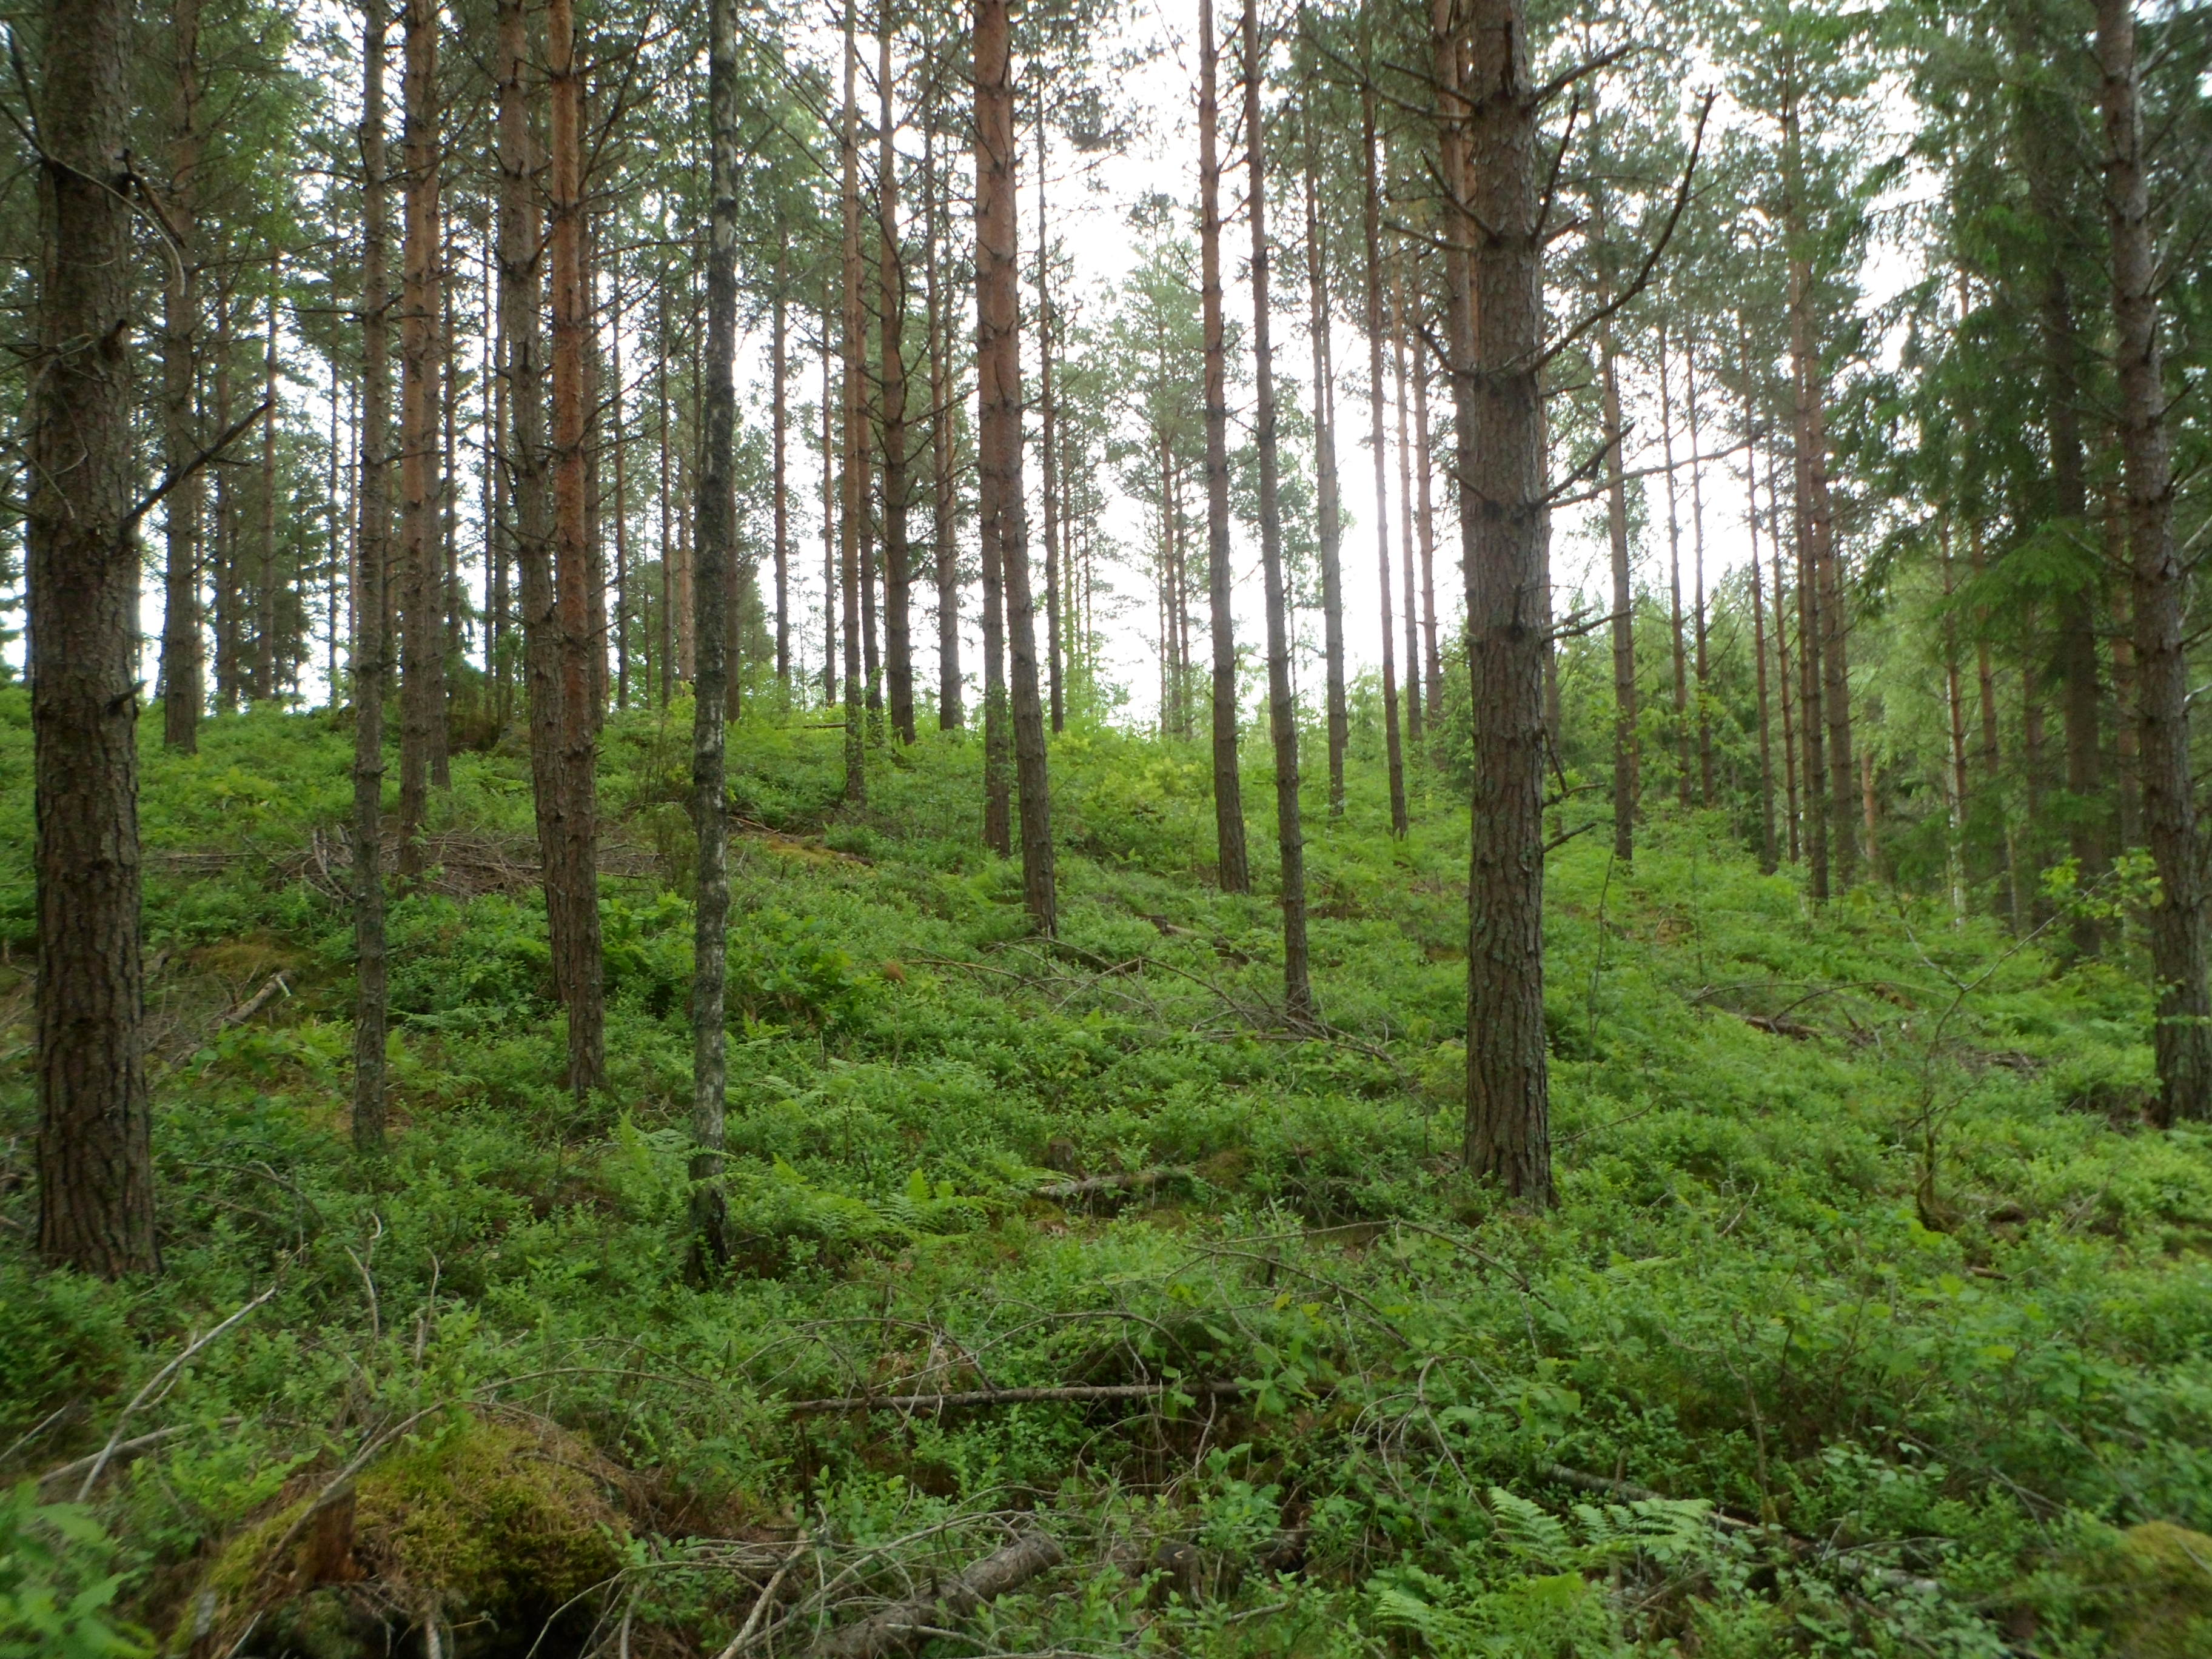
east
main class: Woodland
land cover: Pine dominated coniferous woodland
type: boreal forest
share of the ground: 50 - 75 %
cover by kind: coniferous forest trees 65 %, broadleaved forest trees 10 %, shrubs 10 %, lichens and mosses 10 %, herbaceous plants 5 %
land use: Forestry
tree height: > 5 m
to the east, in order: Pine dominated coniferous woodland; Grassland with sparse tree/shrub cover; Paved roads, cycling and walking lanes; Electric lines; Grassland with sparse tree/shrub cover; Broadleaved woodland; Tracks; Ditches and canals; Broadleaved woodland
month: June
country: SE
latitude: 56.9200
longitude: 14.4814
